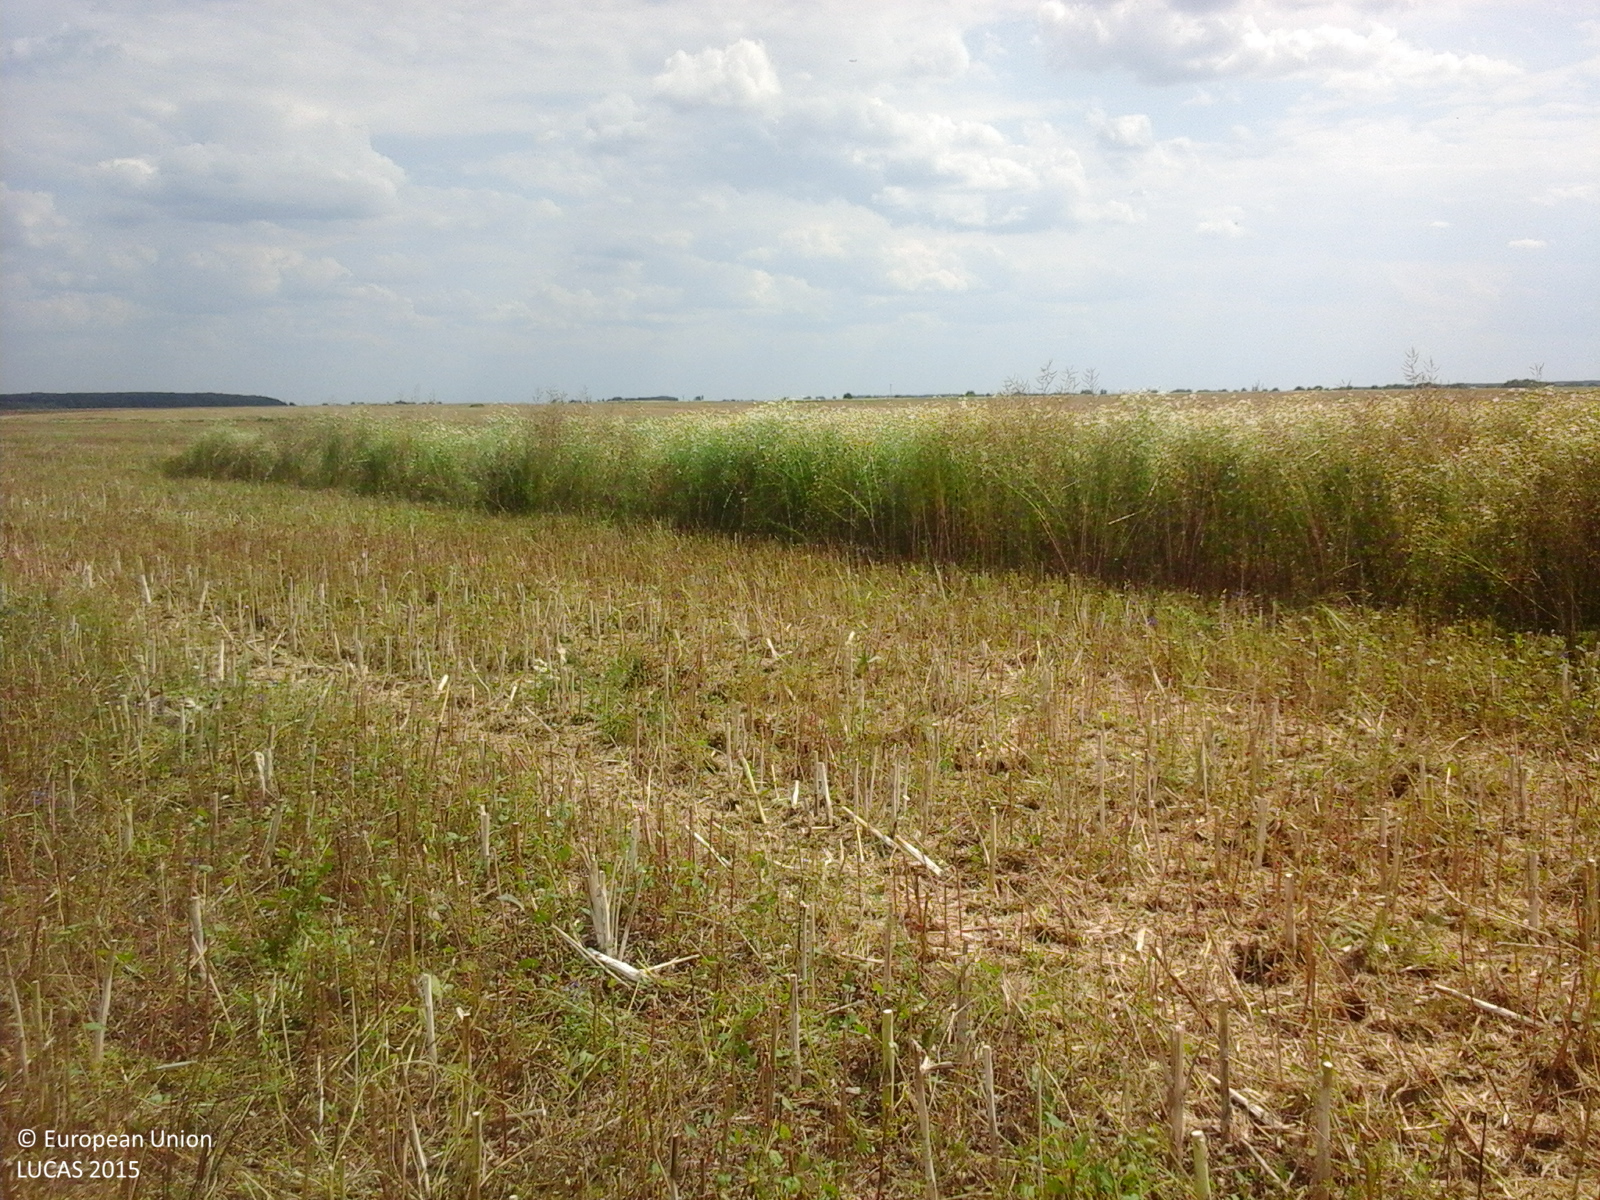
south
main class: Cropland
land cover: Rape and turnip rape
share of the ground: < 10 %
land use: Agriculture (excluding fallow land and kitchen gardens)
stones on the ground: 10 - 25 %
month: June
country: RO
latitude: 44.6120
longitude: 26.3043
